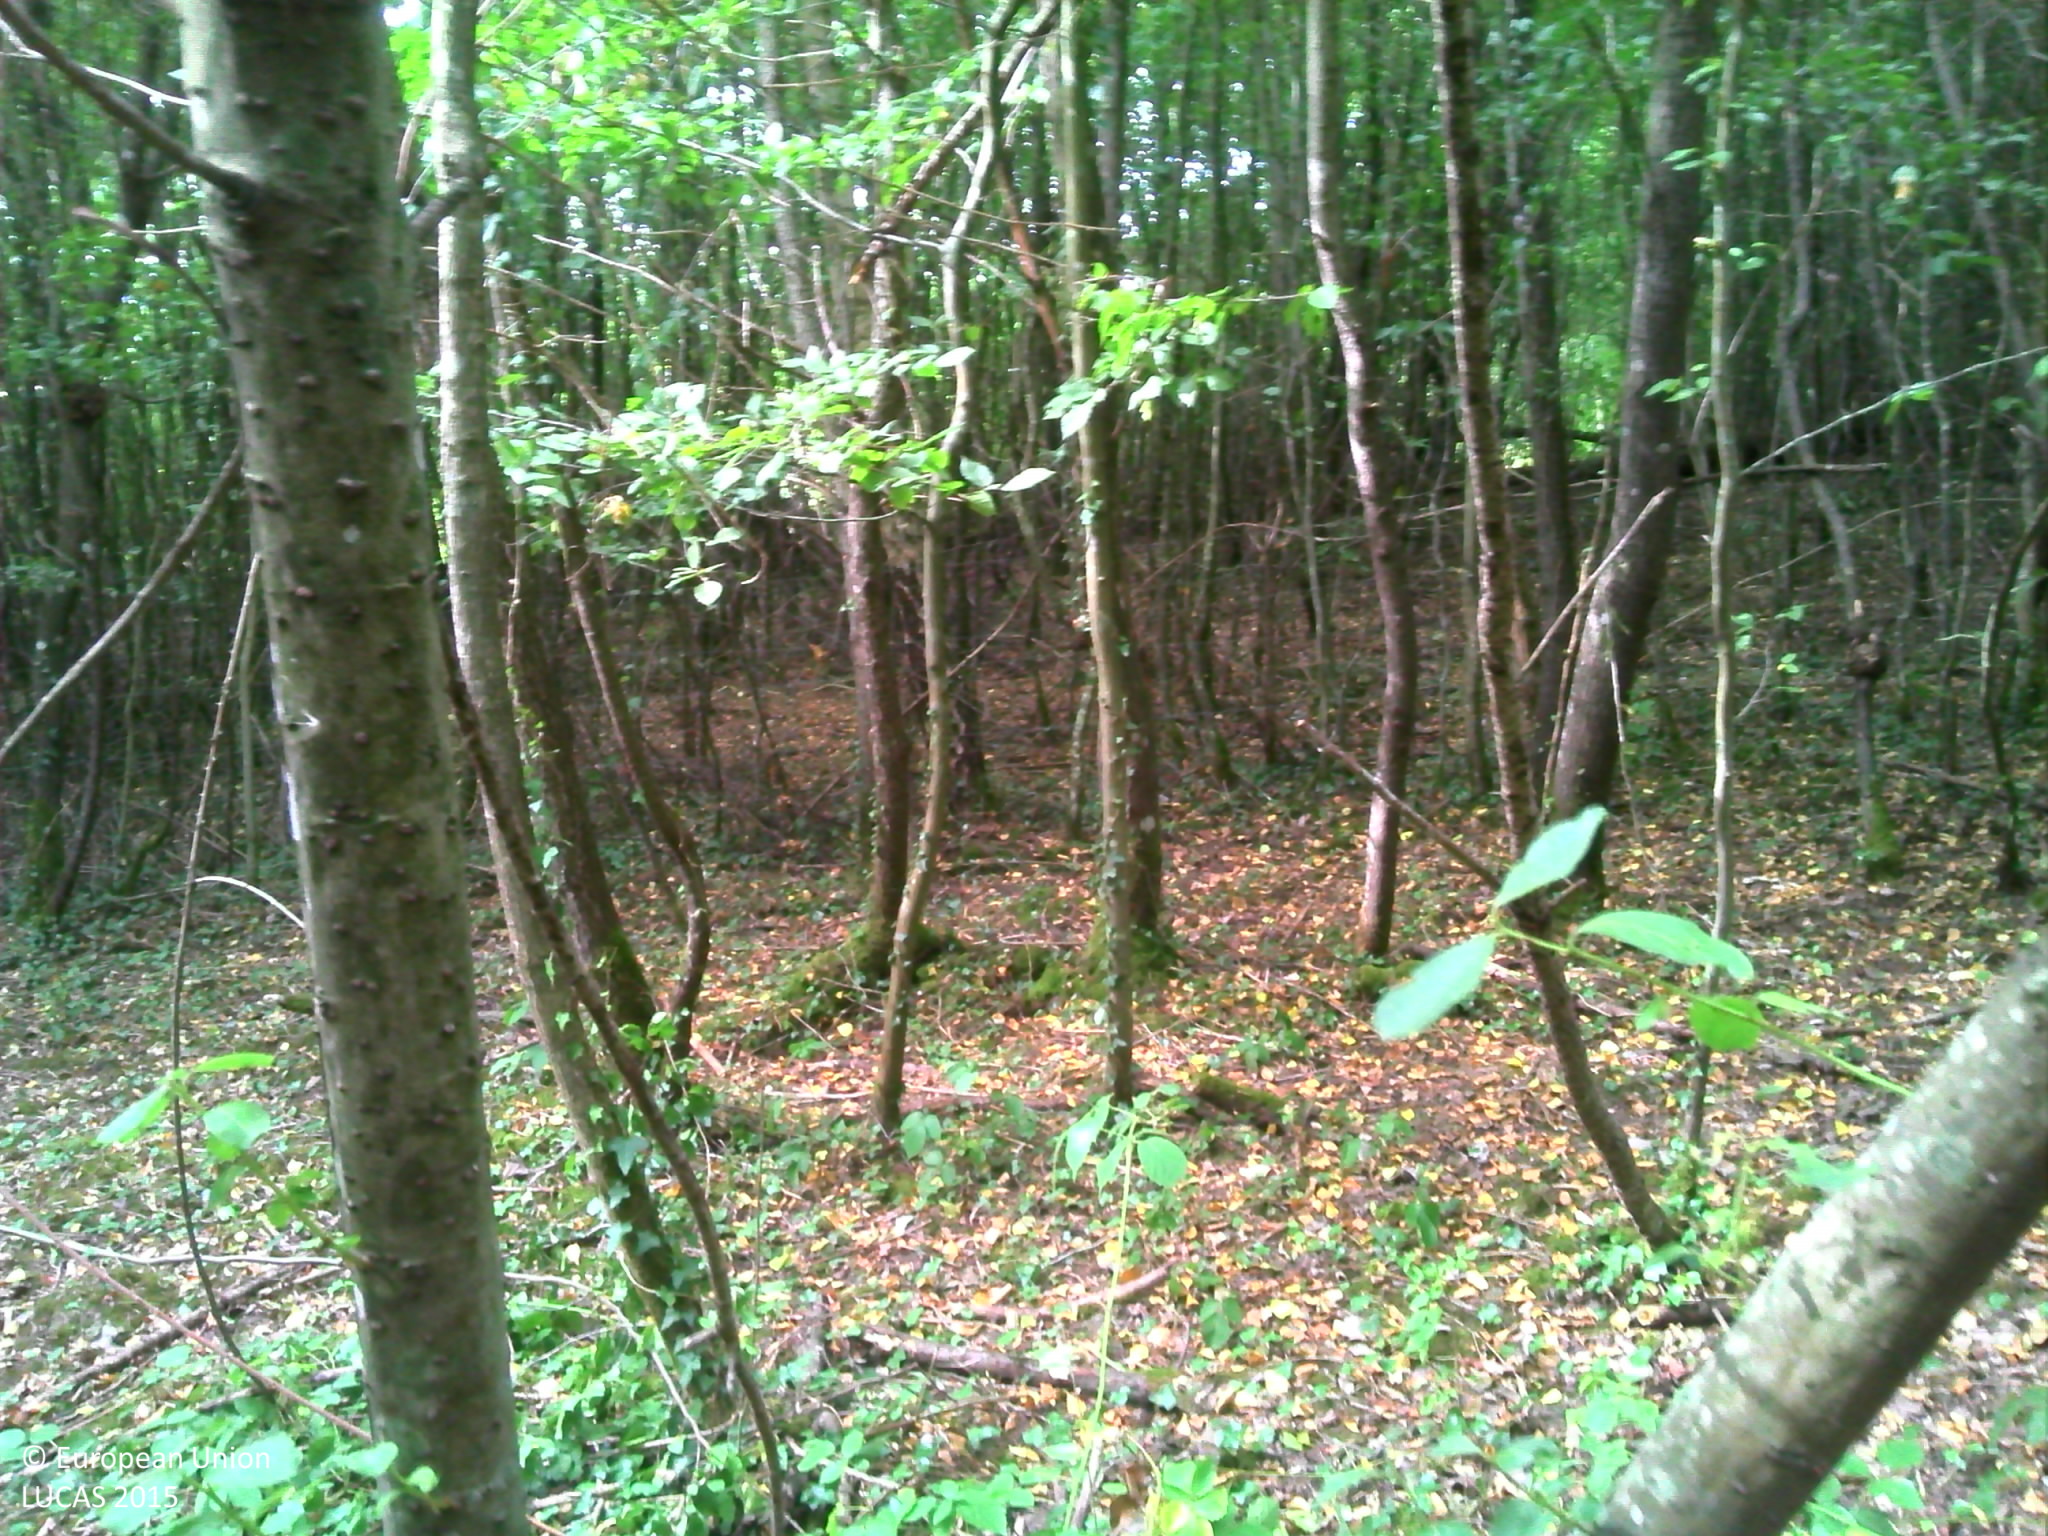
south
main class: Woodland
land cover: Broadleaved woodland
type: beech forest
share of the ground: > 75 %
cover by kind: broadleaved forest trees 50 %, lichens and mosses 20 %, herbaceous plants 10 %, unconsolidated bare surface 10 %
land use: Forestry
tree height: > 5 m
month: August
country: FR
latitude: 48.8860
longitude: 3.2965
